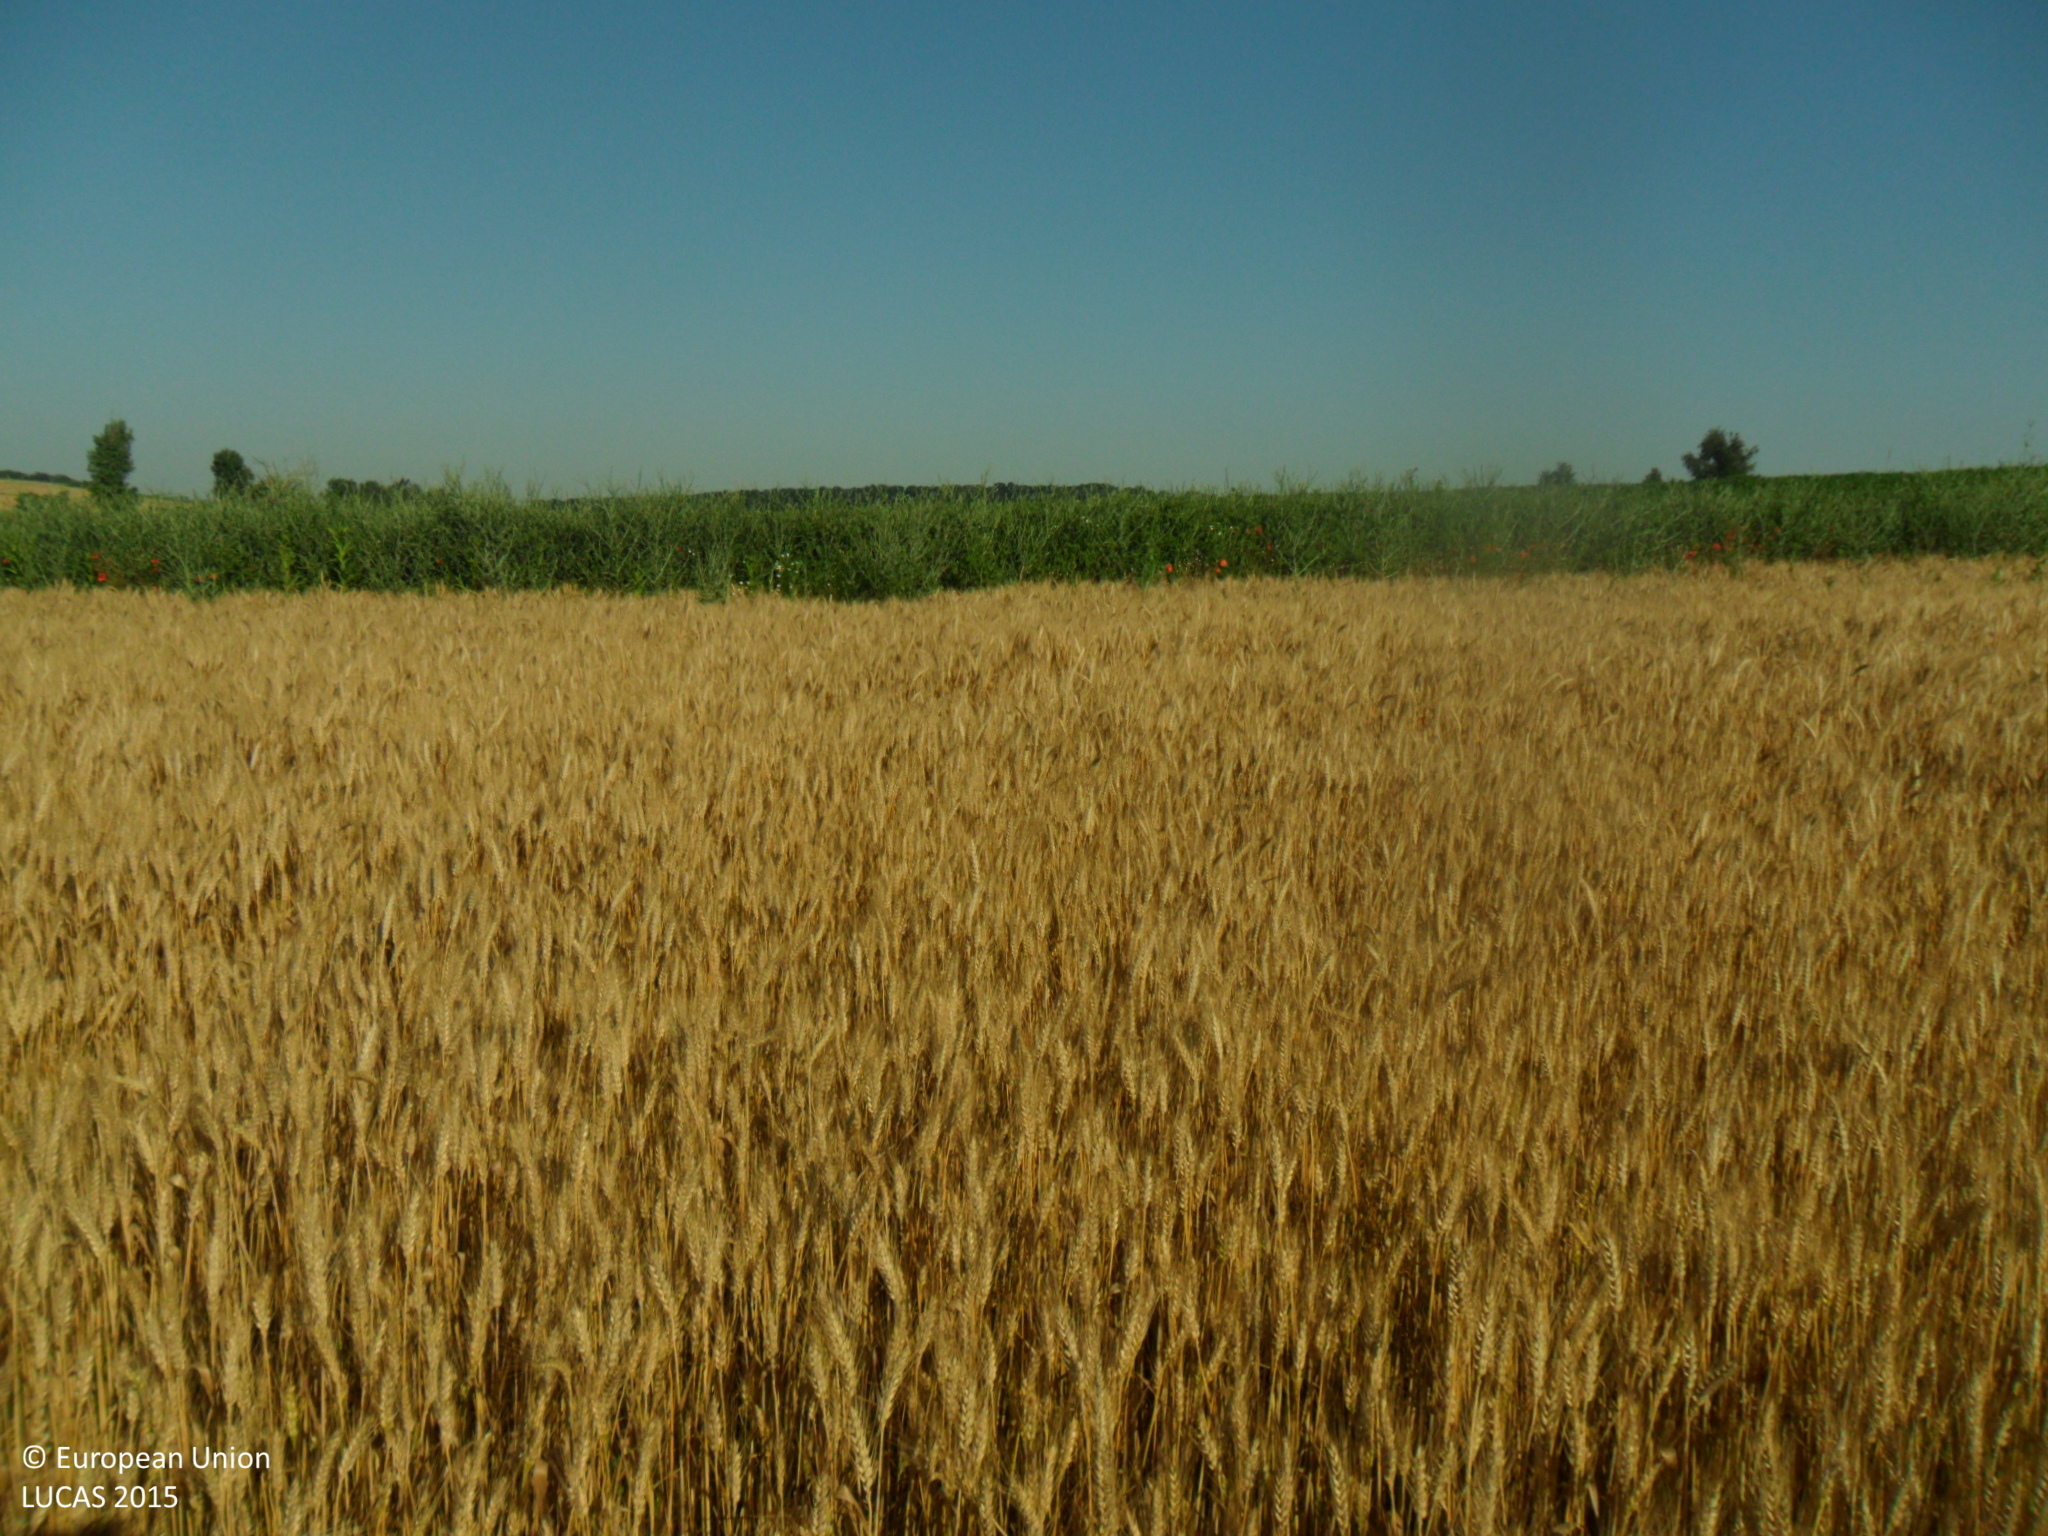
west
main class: Cropland
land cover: Common wheat
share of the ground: > 75 %
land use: Agriculture (excluding fallow land and kitchen gardens)
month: June
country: BG
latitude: 43.3275
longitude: 27.0743
